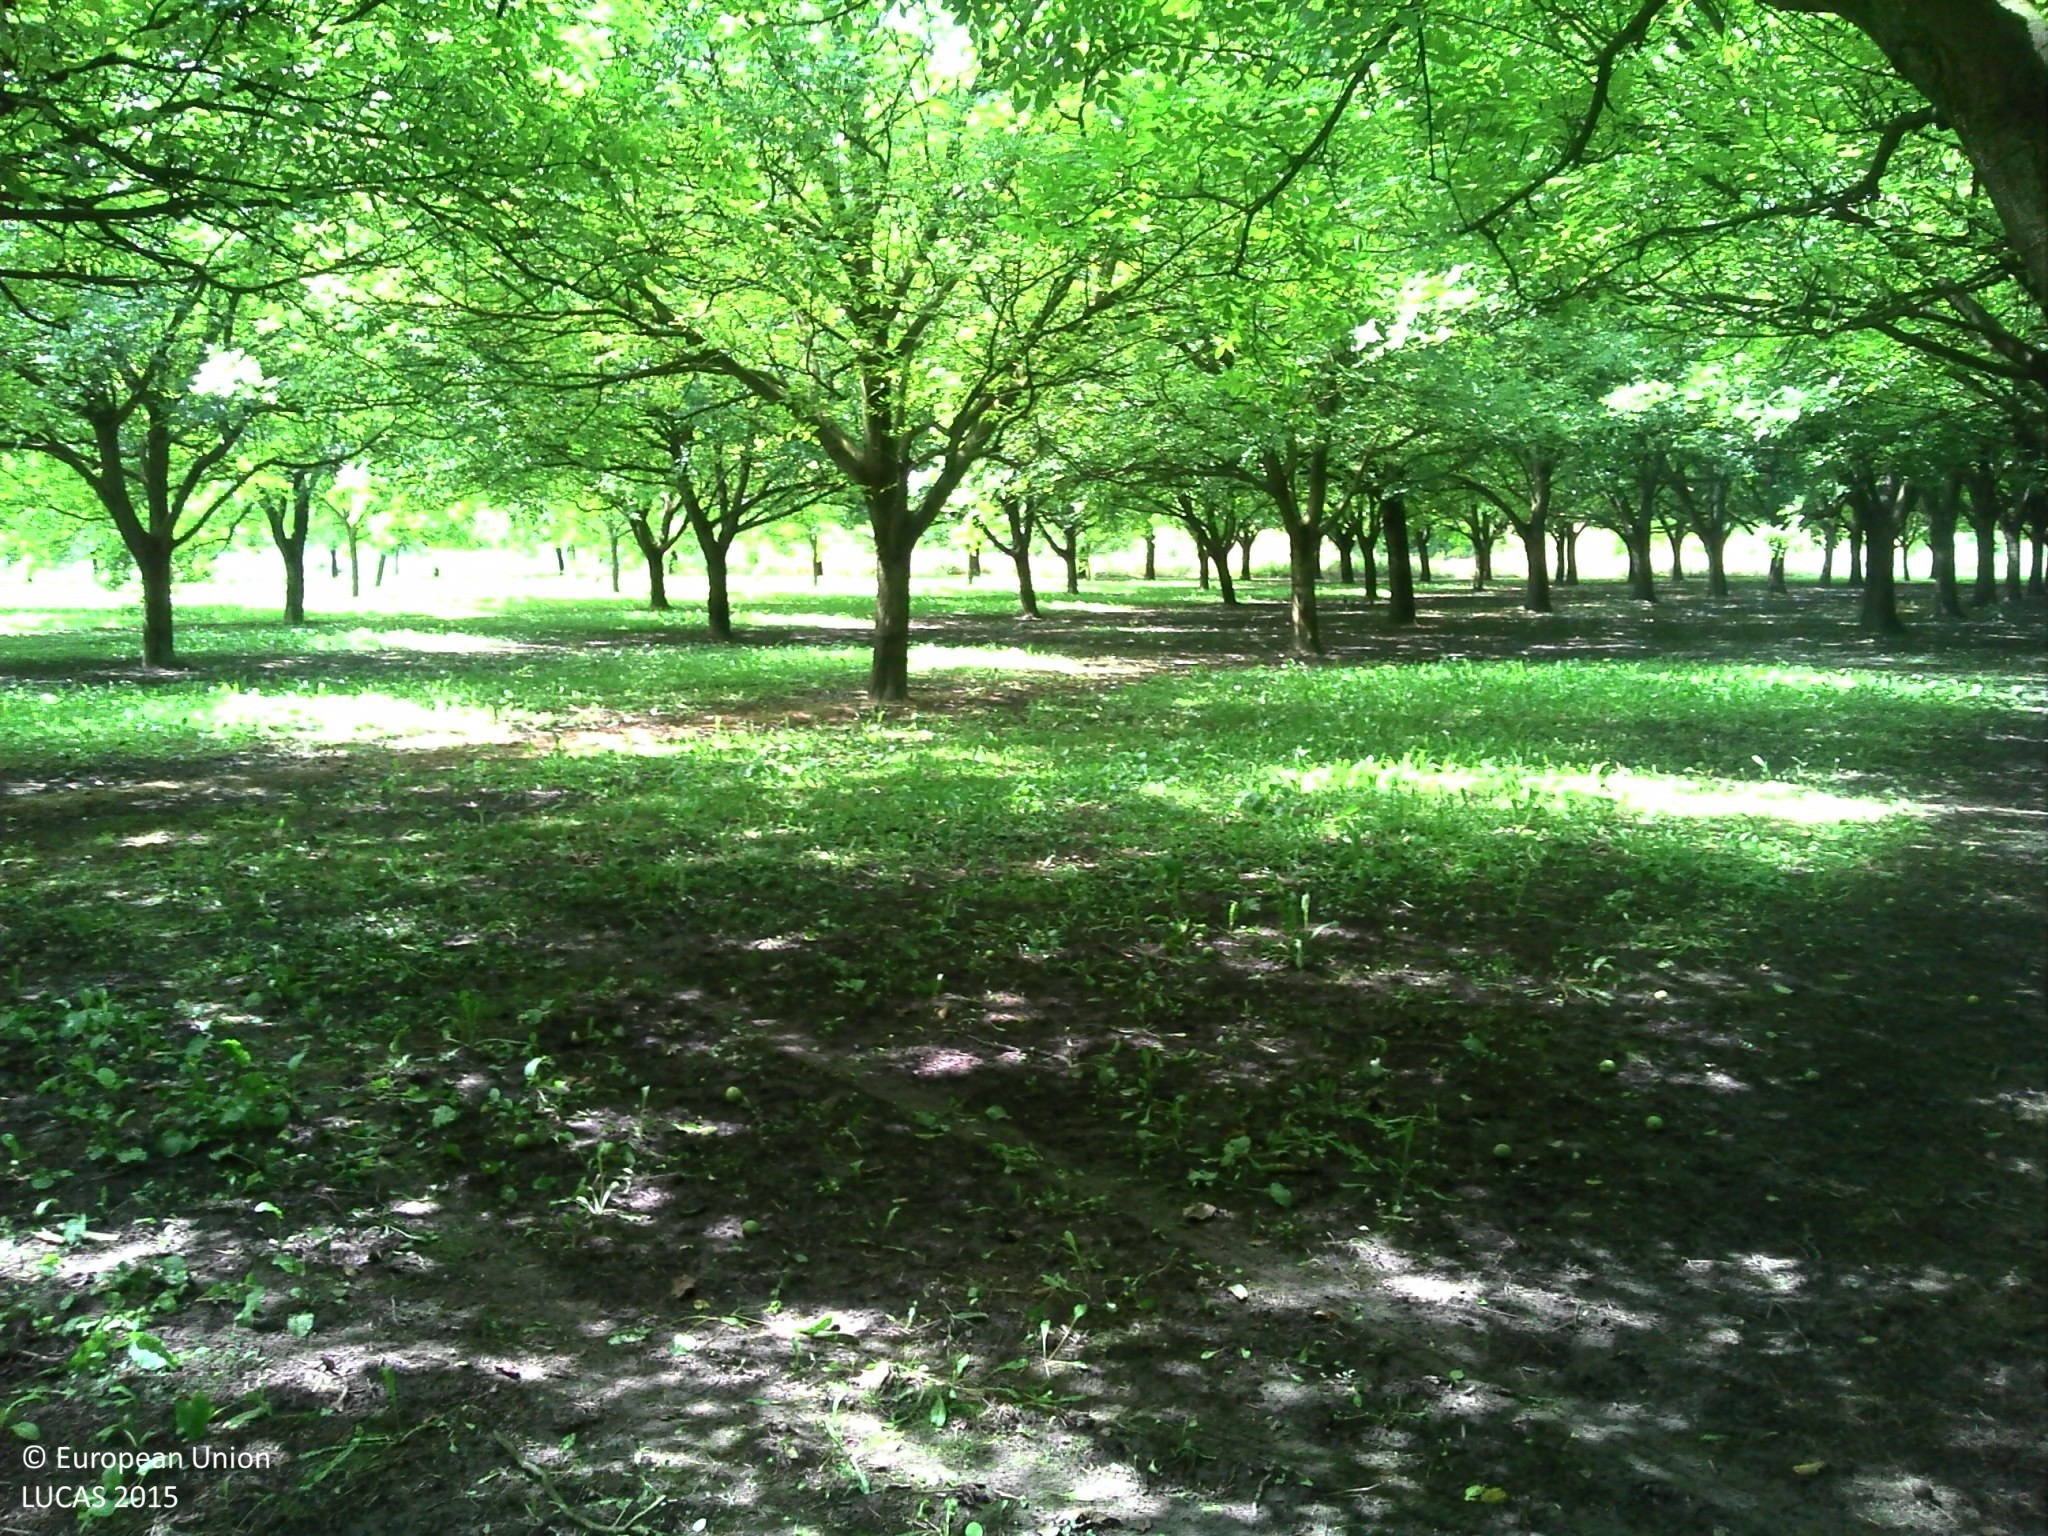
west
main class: Cropland
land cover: Nuts trees
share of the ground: > 75 %
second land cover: Spontaneously vegetated surfaces
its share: 25 - 50 %
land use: Agriculture (excluding fallow land and kitchen gardens)
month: August
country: FR
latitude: 45.2273
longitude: 5.4839
